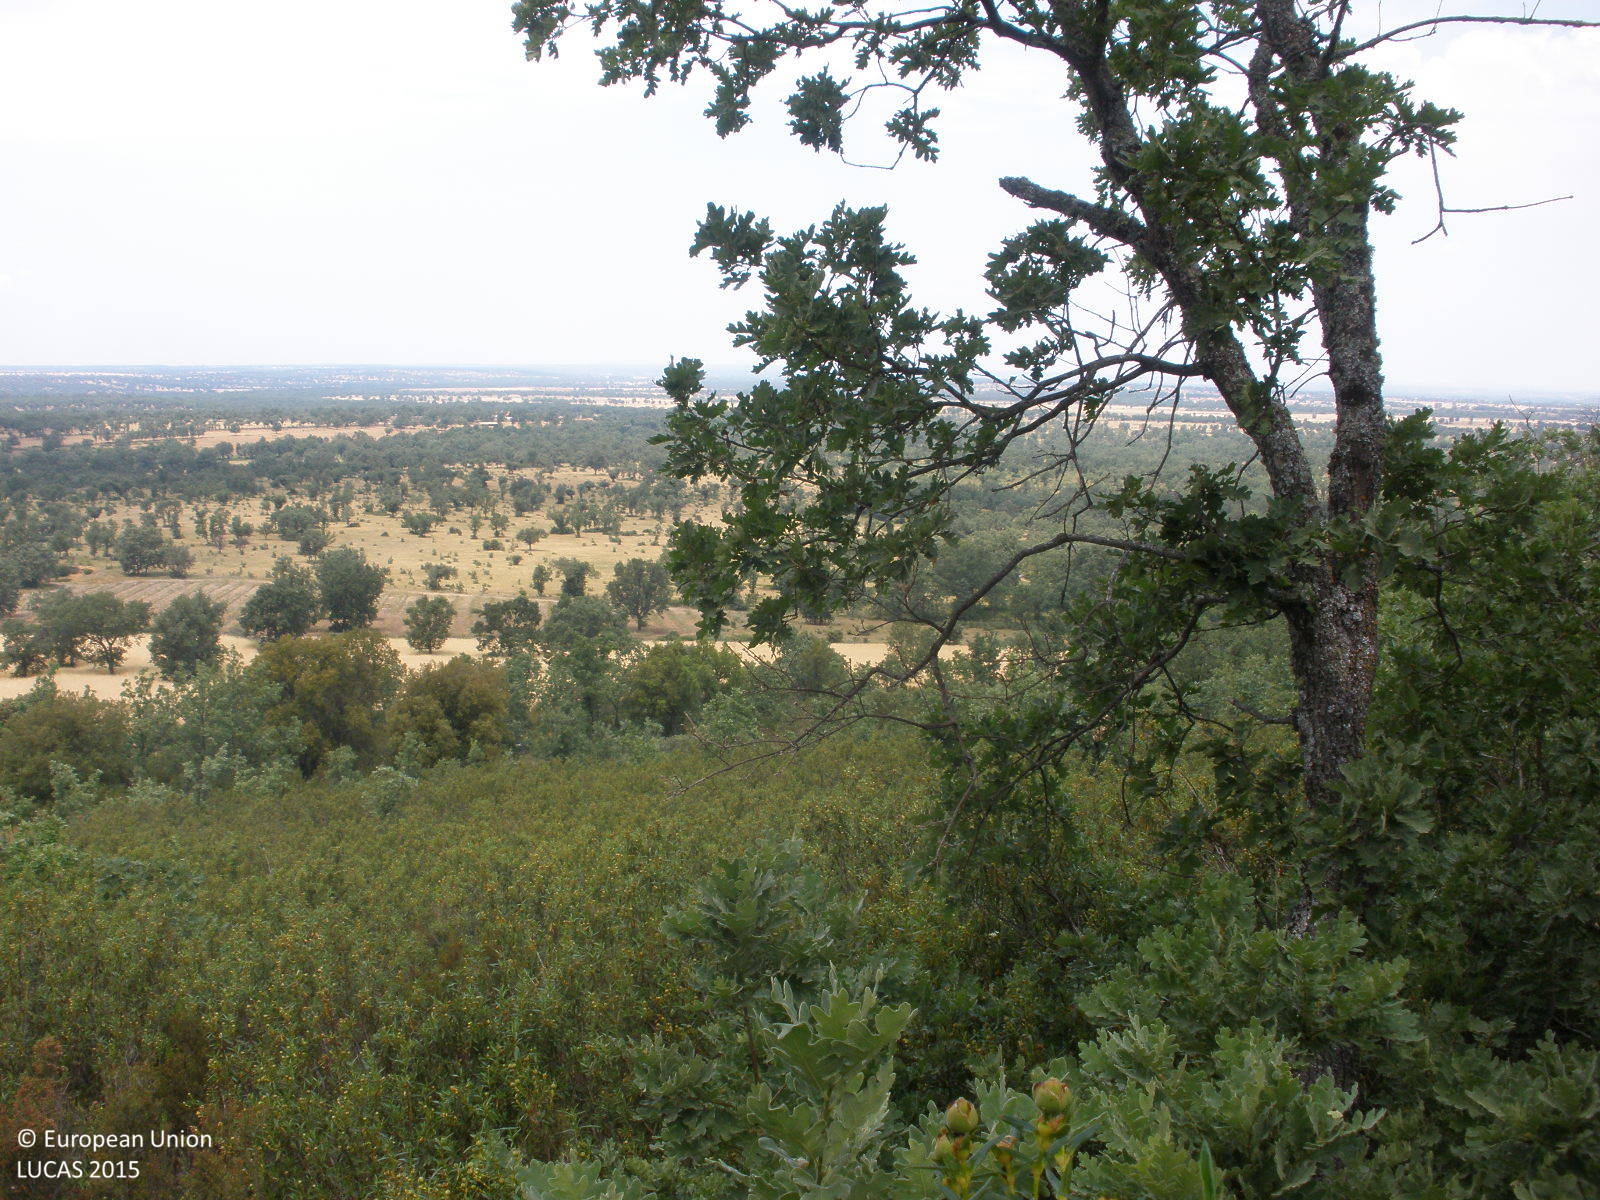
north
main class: Shrubland
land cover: Shrubland with sparse tree cover
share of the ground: > 75 %
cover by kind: shrubs 95 %, broadleaved forest trees 5 %
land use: Semi-natural and natural areas not in use
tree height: > 5 m
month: June
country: ES
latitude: 40.5786
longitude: -6.3529
